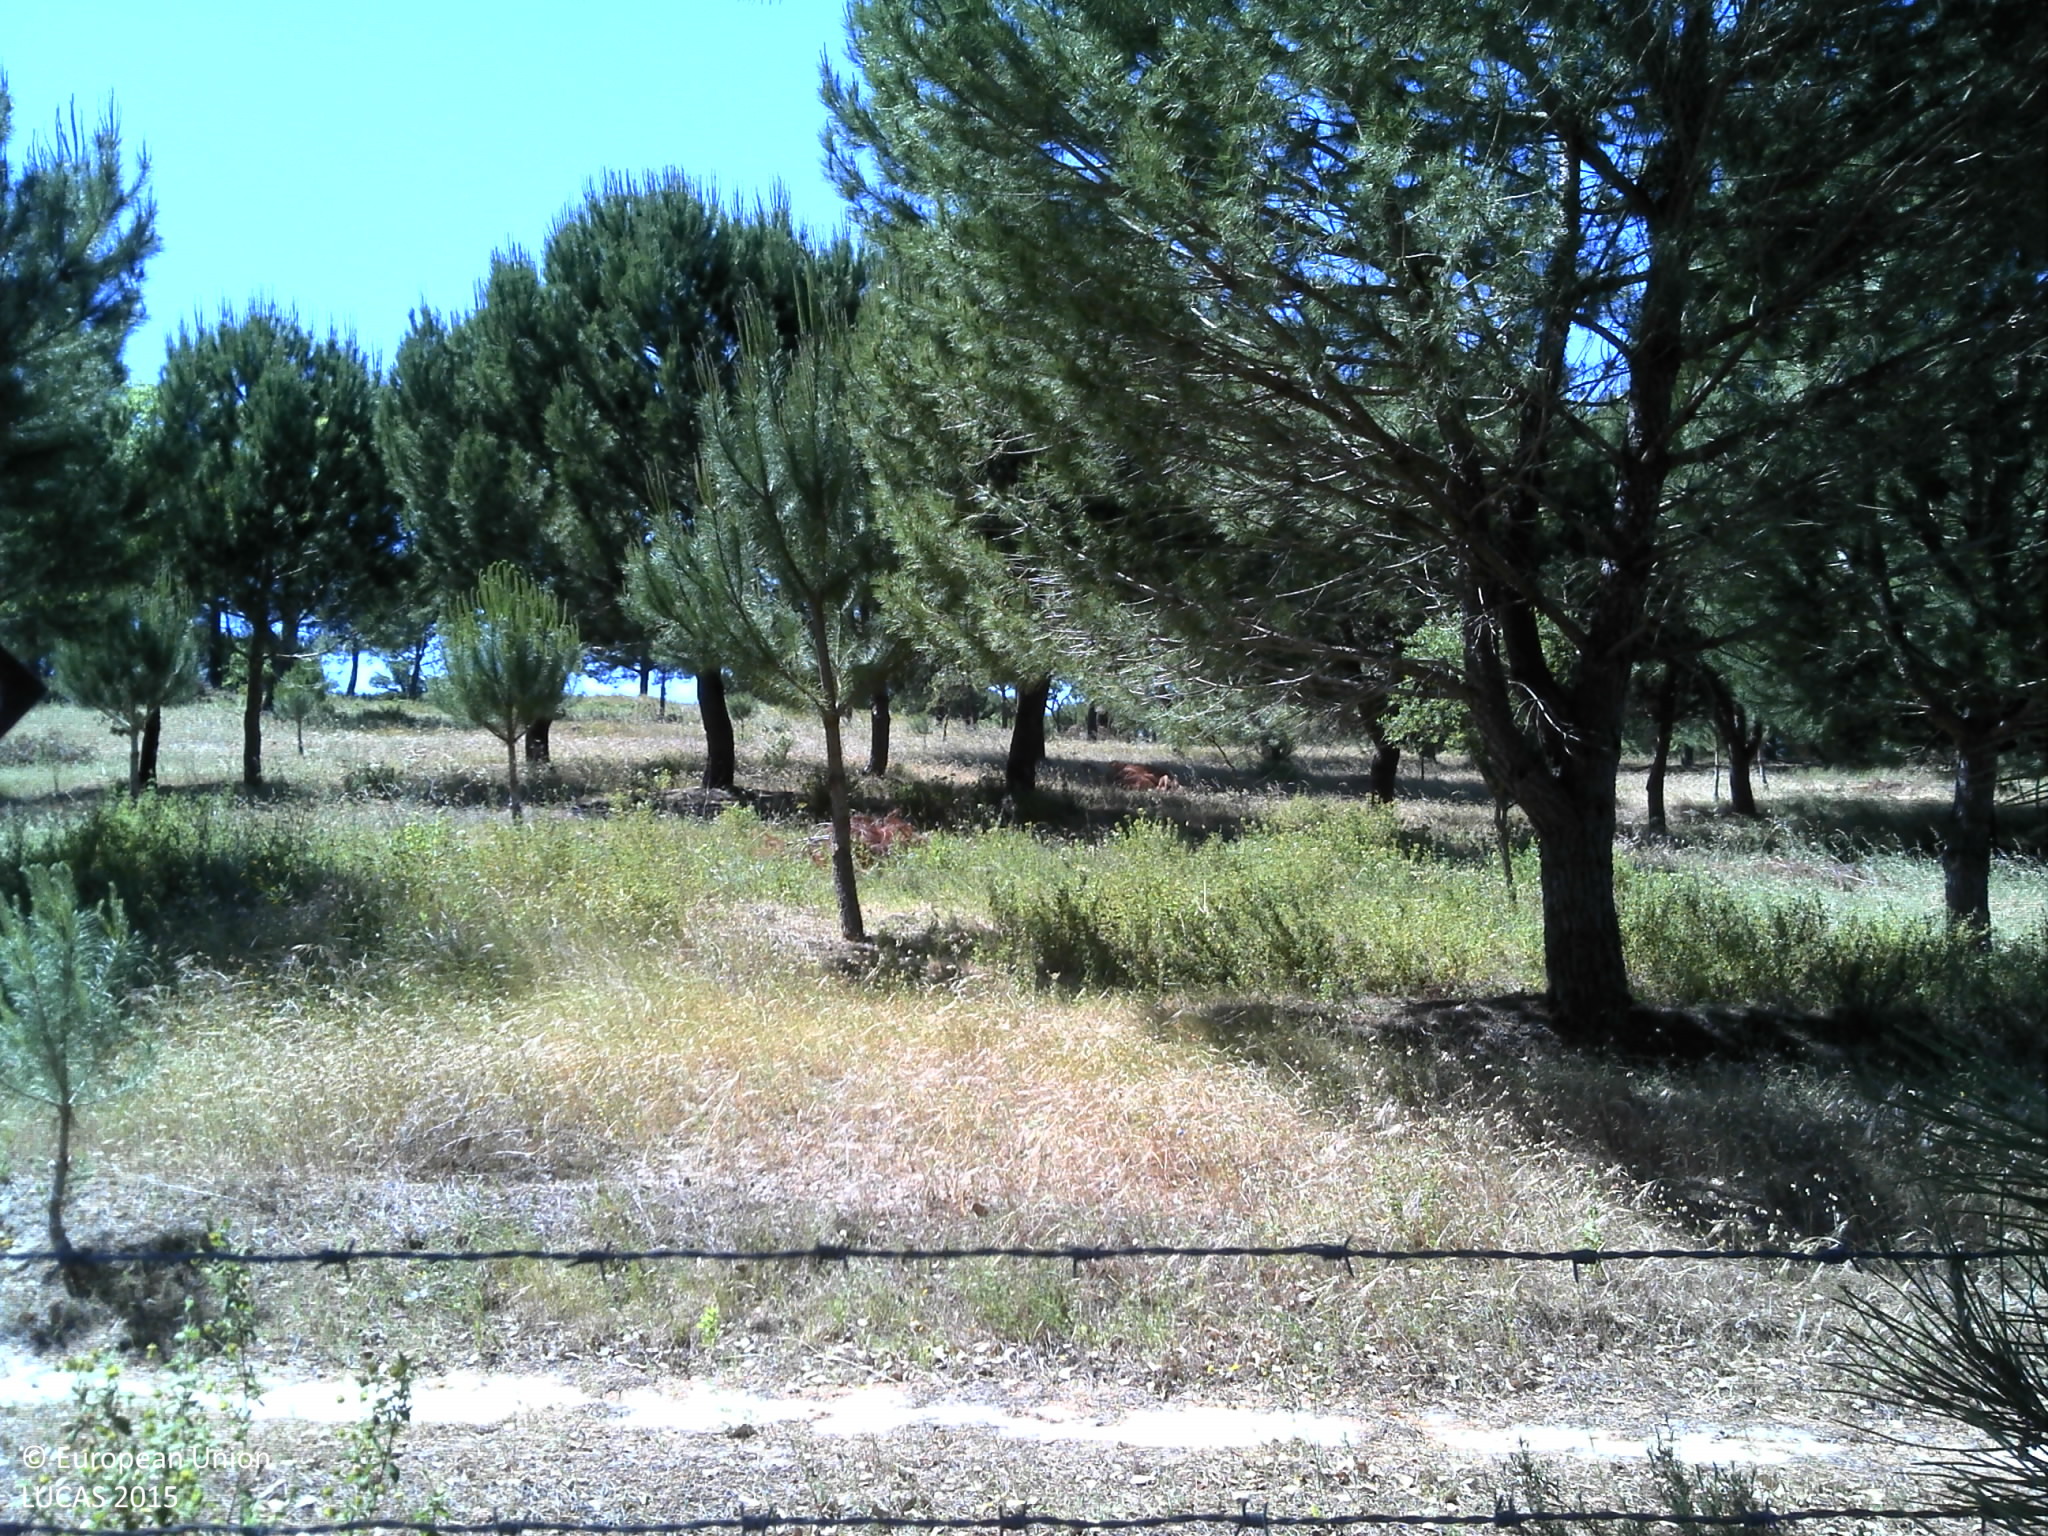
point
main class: Woodland
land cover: Pine dominated coniferous woodland
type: coniferous forest of the mediterranean region
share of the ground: 10 - 25 %
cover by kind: herbaceous plants 60 %, coniferous forest trees 20 %, unconsolidated bare surface 20 %
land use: Forestry
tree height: > 5 m
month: May
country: PT
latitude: 38.6001
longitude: -8.5073
